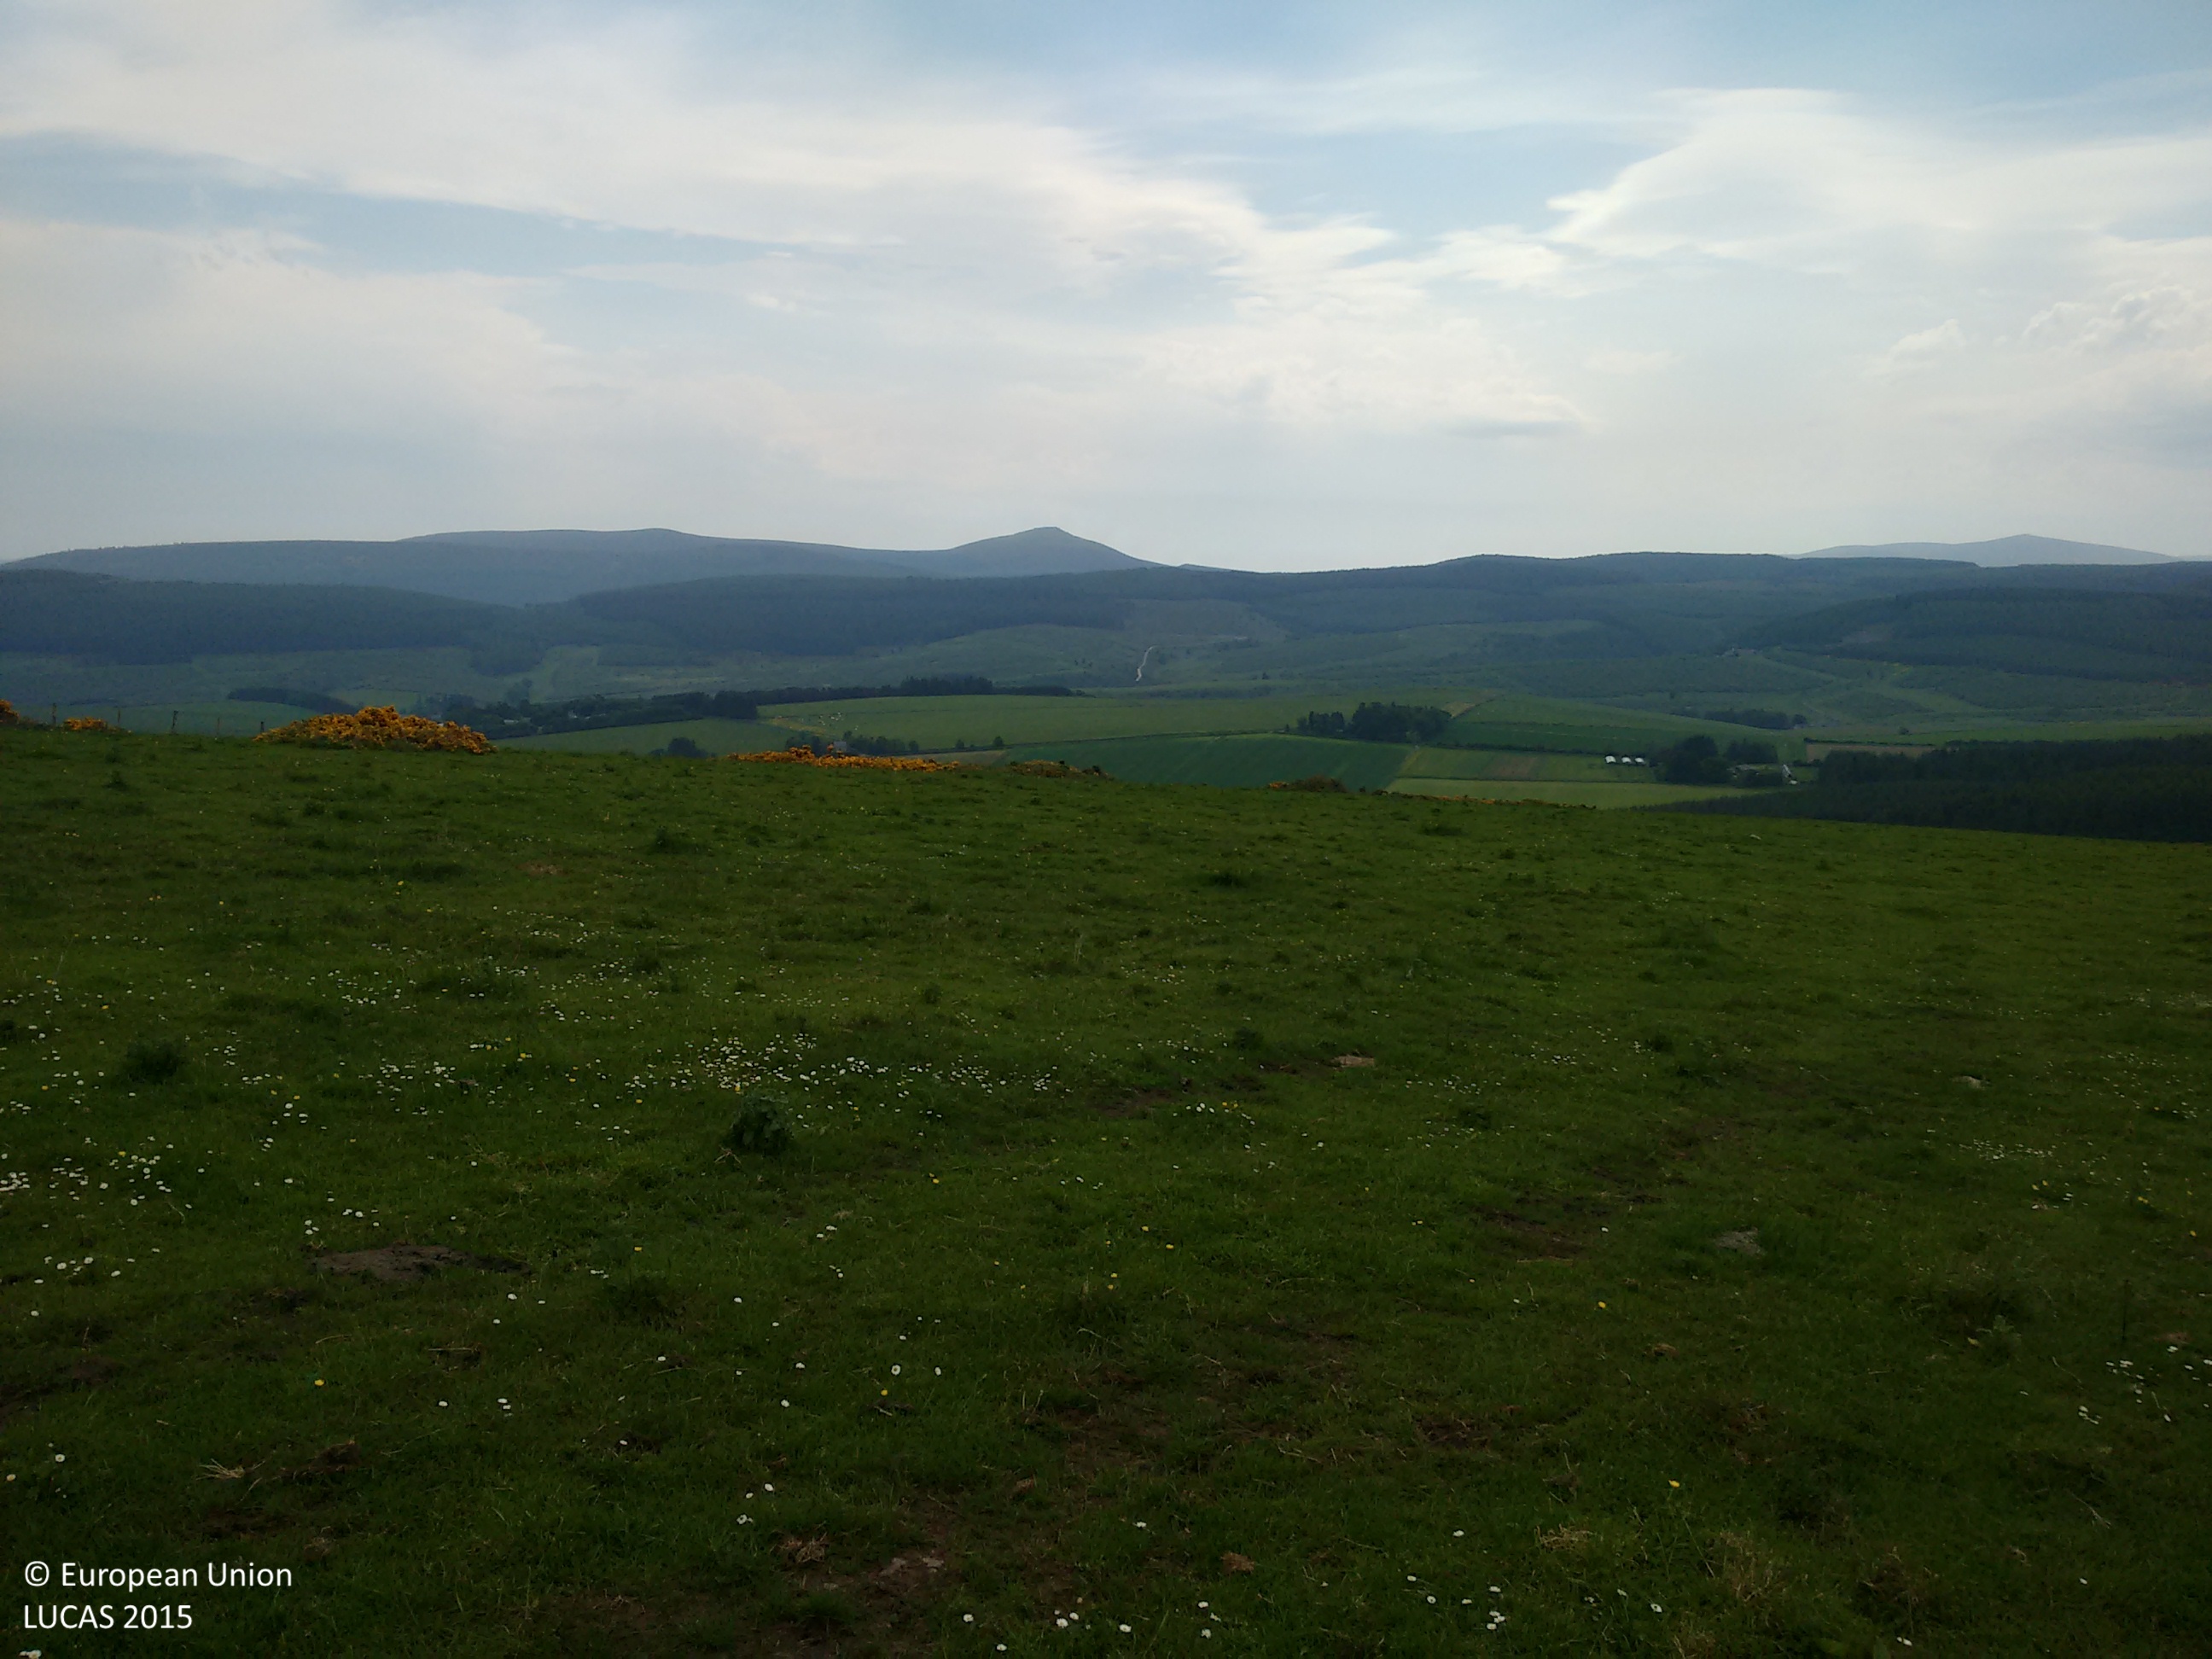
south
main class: Grassland
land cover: Grassland without tree/shrub cover
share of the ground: > 75 %
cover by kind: herbaceous plants 100 %
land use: Agriculture (excluding fallow land and kitchen gardens)
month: July
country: GB
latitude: 57.4156
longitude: -2.8621
